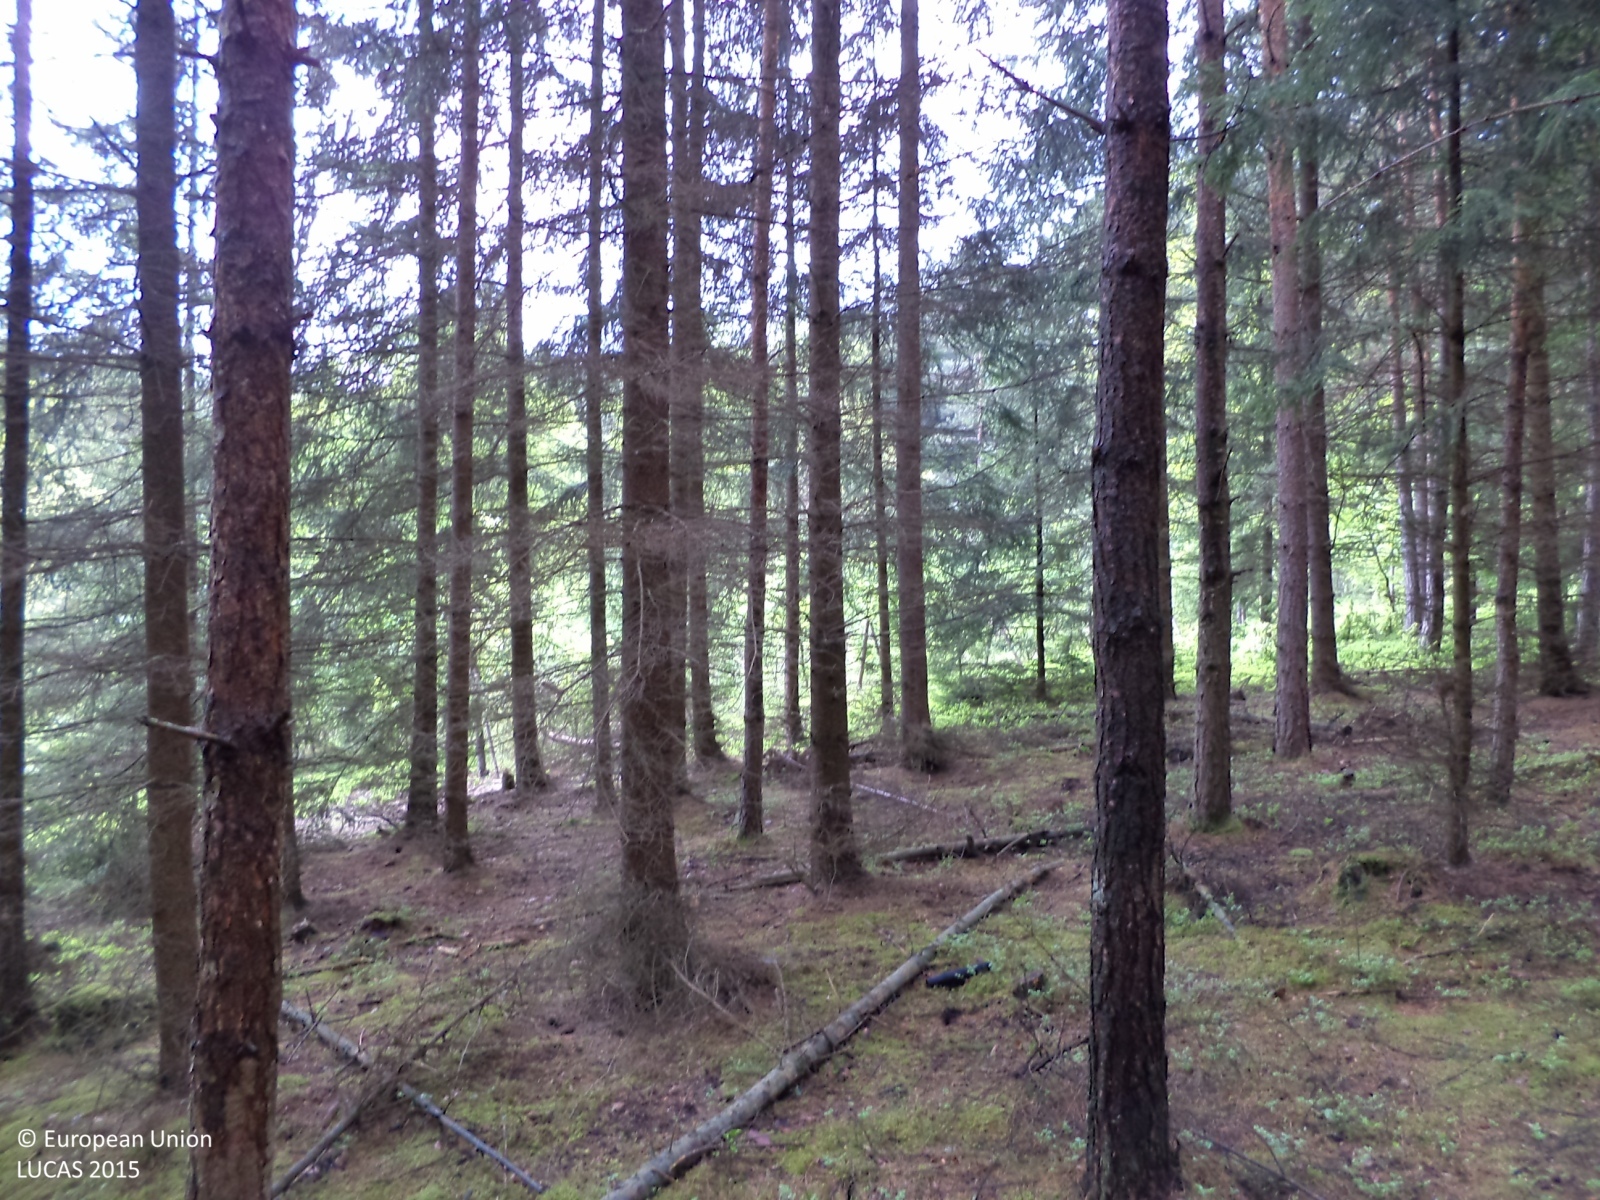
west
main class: Woodland
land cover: Spruce dominated coniferous woodland
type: hemiboreal forest and nemoral coniferous forest and mixed broadleaved-coniferous forest
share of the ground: > 75 %
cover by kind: coniferous forest trees 90 %, lichens and mosses 10 %
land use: Forestry
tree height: > 5 m
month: May
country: CZ
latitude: 49.3634
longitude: 14.7800
